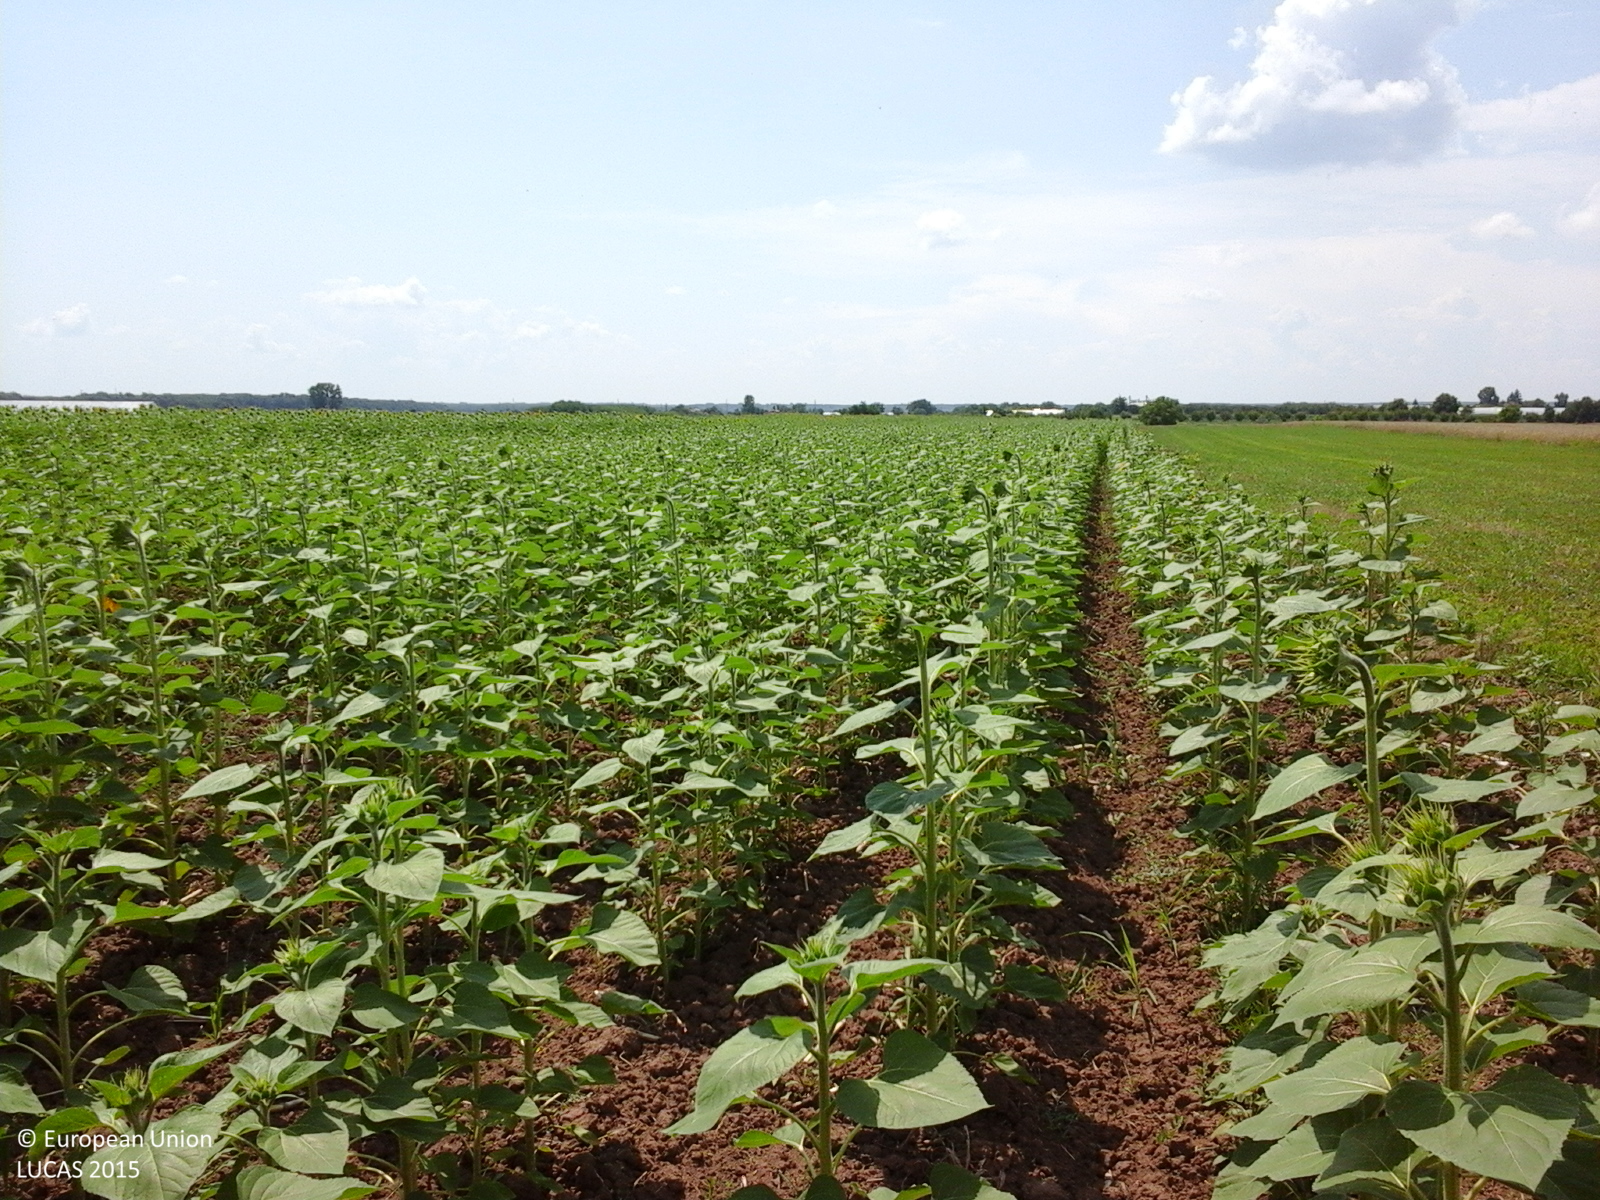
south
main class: Cropland
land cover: Sunflower
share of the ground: > 75 %
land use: Agriculture (excluding fallow land and kitchen gardens)
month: June
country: RO
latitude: 44.2239
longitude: 26.3191
